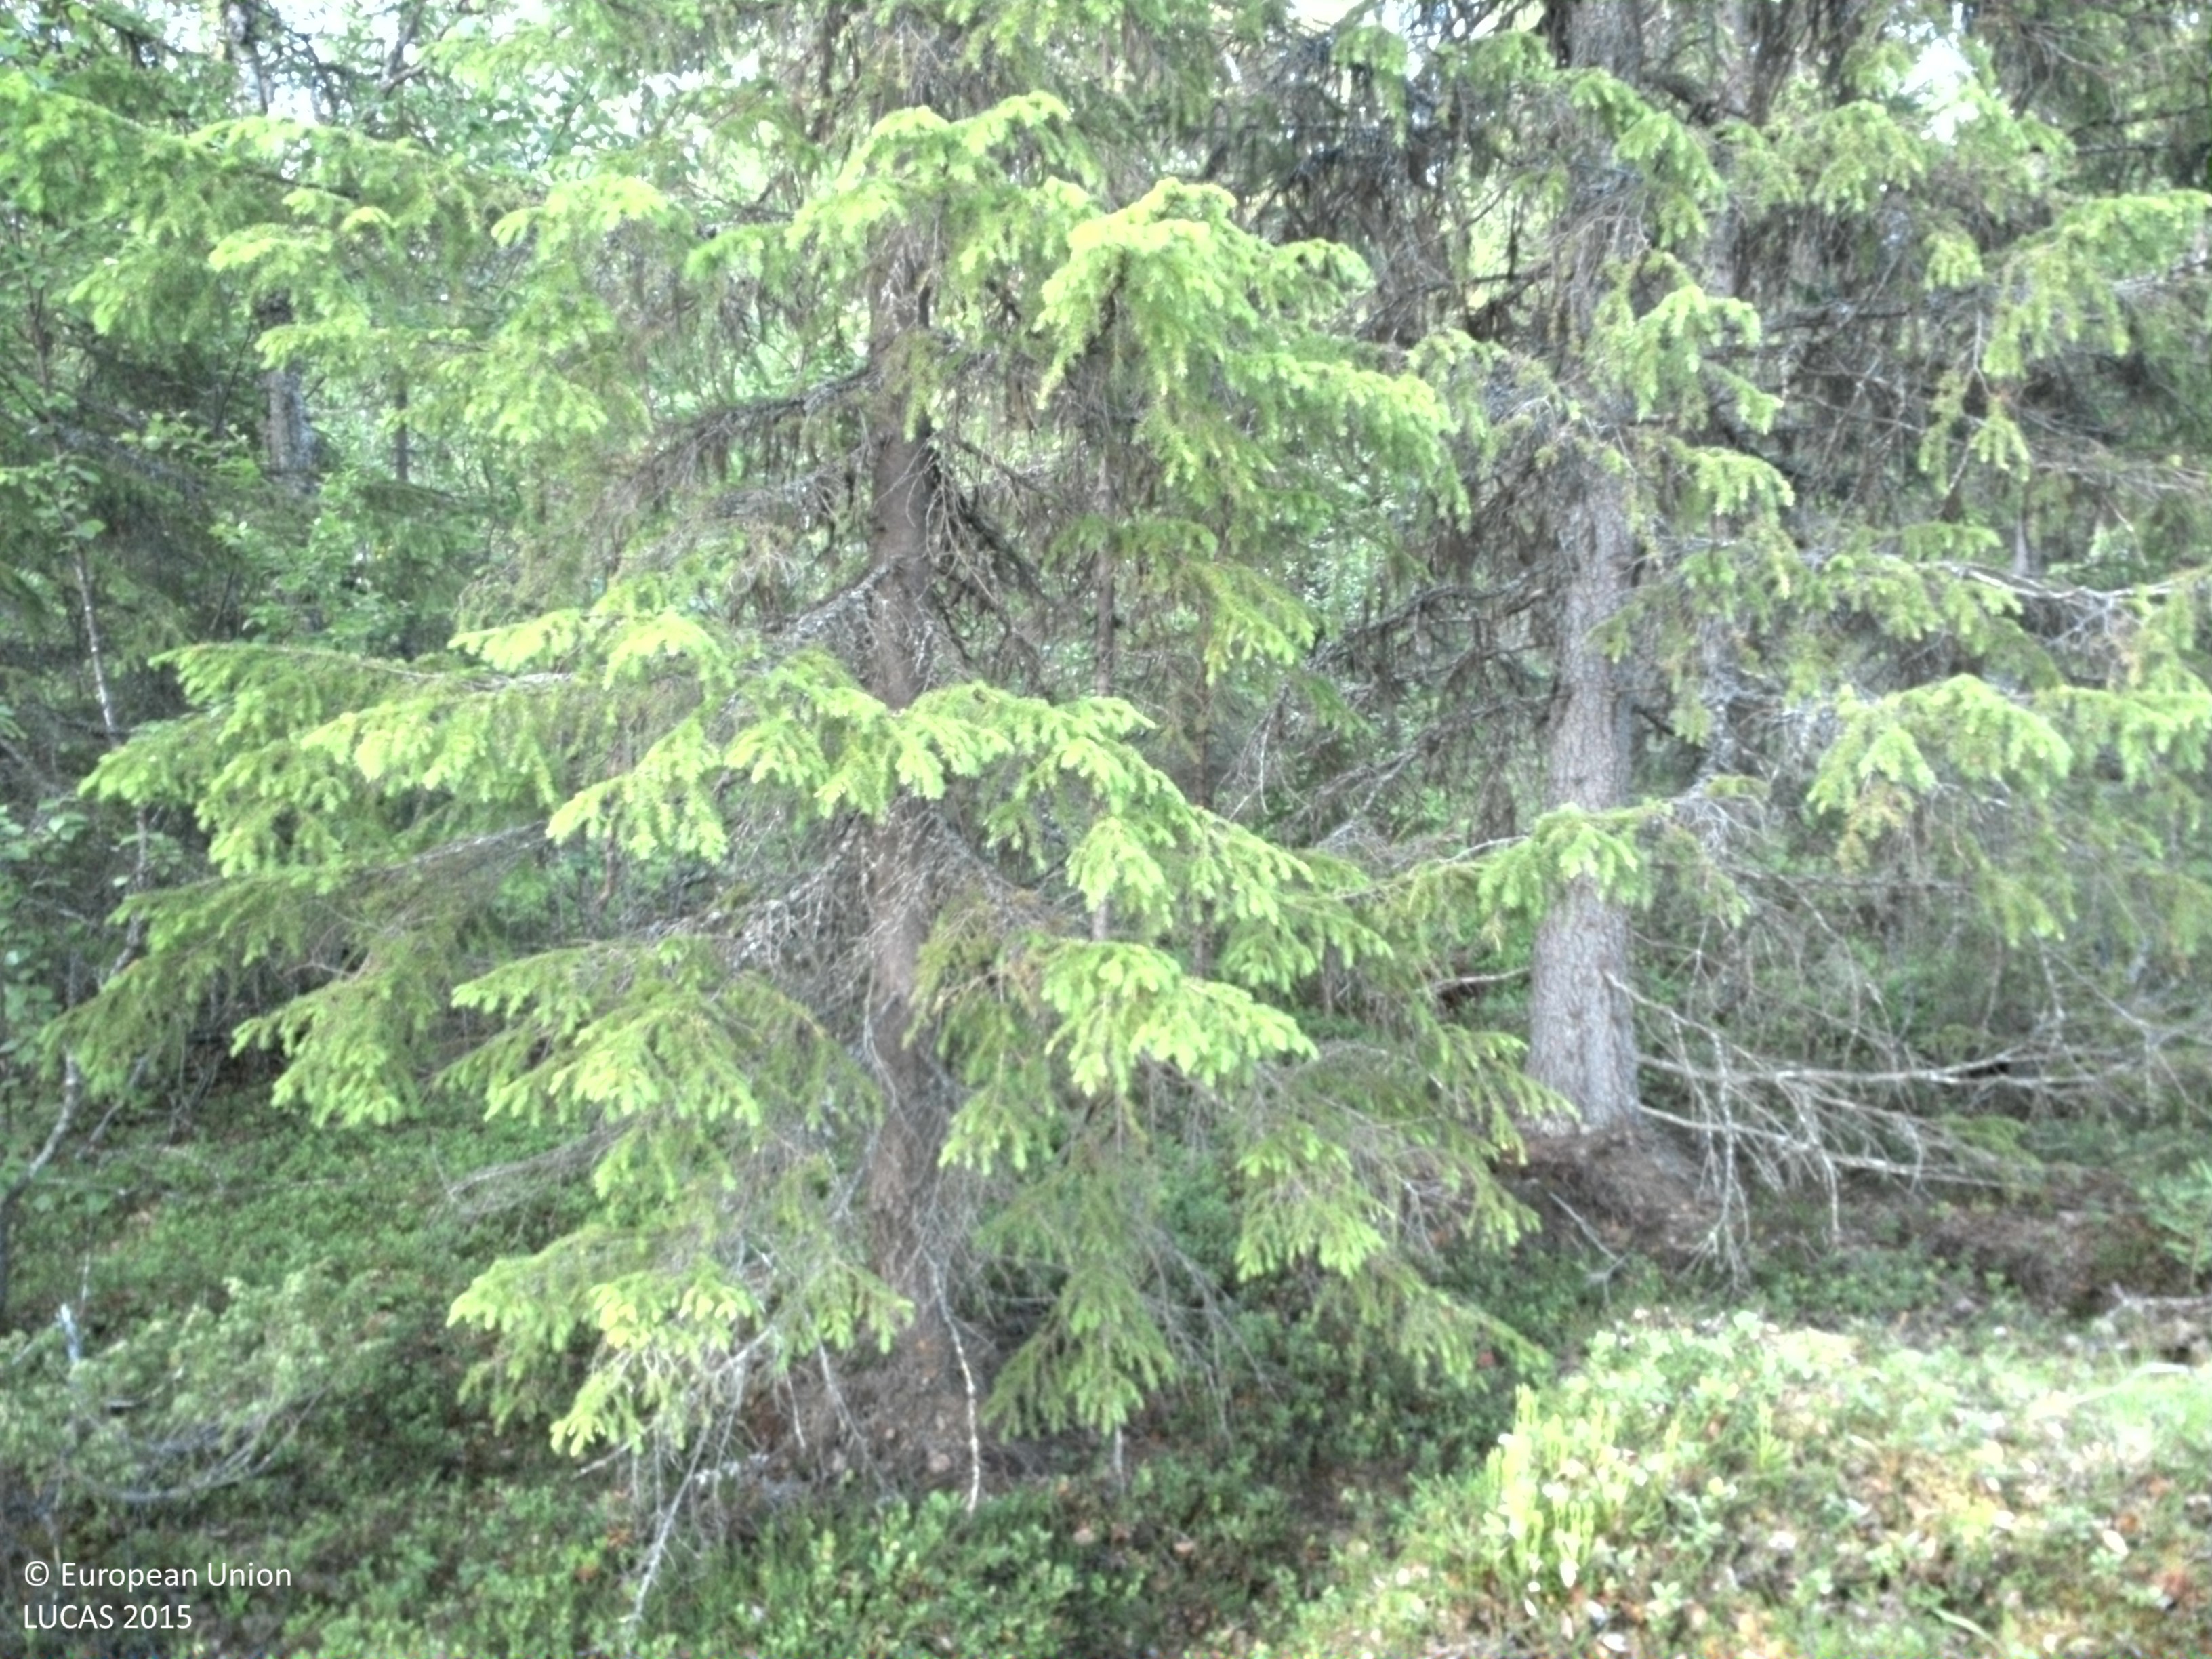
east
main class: Woodland
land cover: Spruce dominated mixed woodland
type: boreal forest
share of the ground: 25 - 50 %
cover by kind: shrubs 45 %, coniferous forest trees 25 %, broadleaved forest trees 20 %, lichens and mosses 10 %
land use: Forestry
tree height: > 5 m
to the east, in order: Spruce dominated mixed woodland; Spruce dominated coniferous woodland
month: July
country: SE
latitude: 65.5365
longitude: 15.4400
